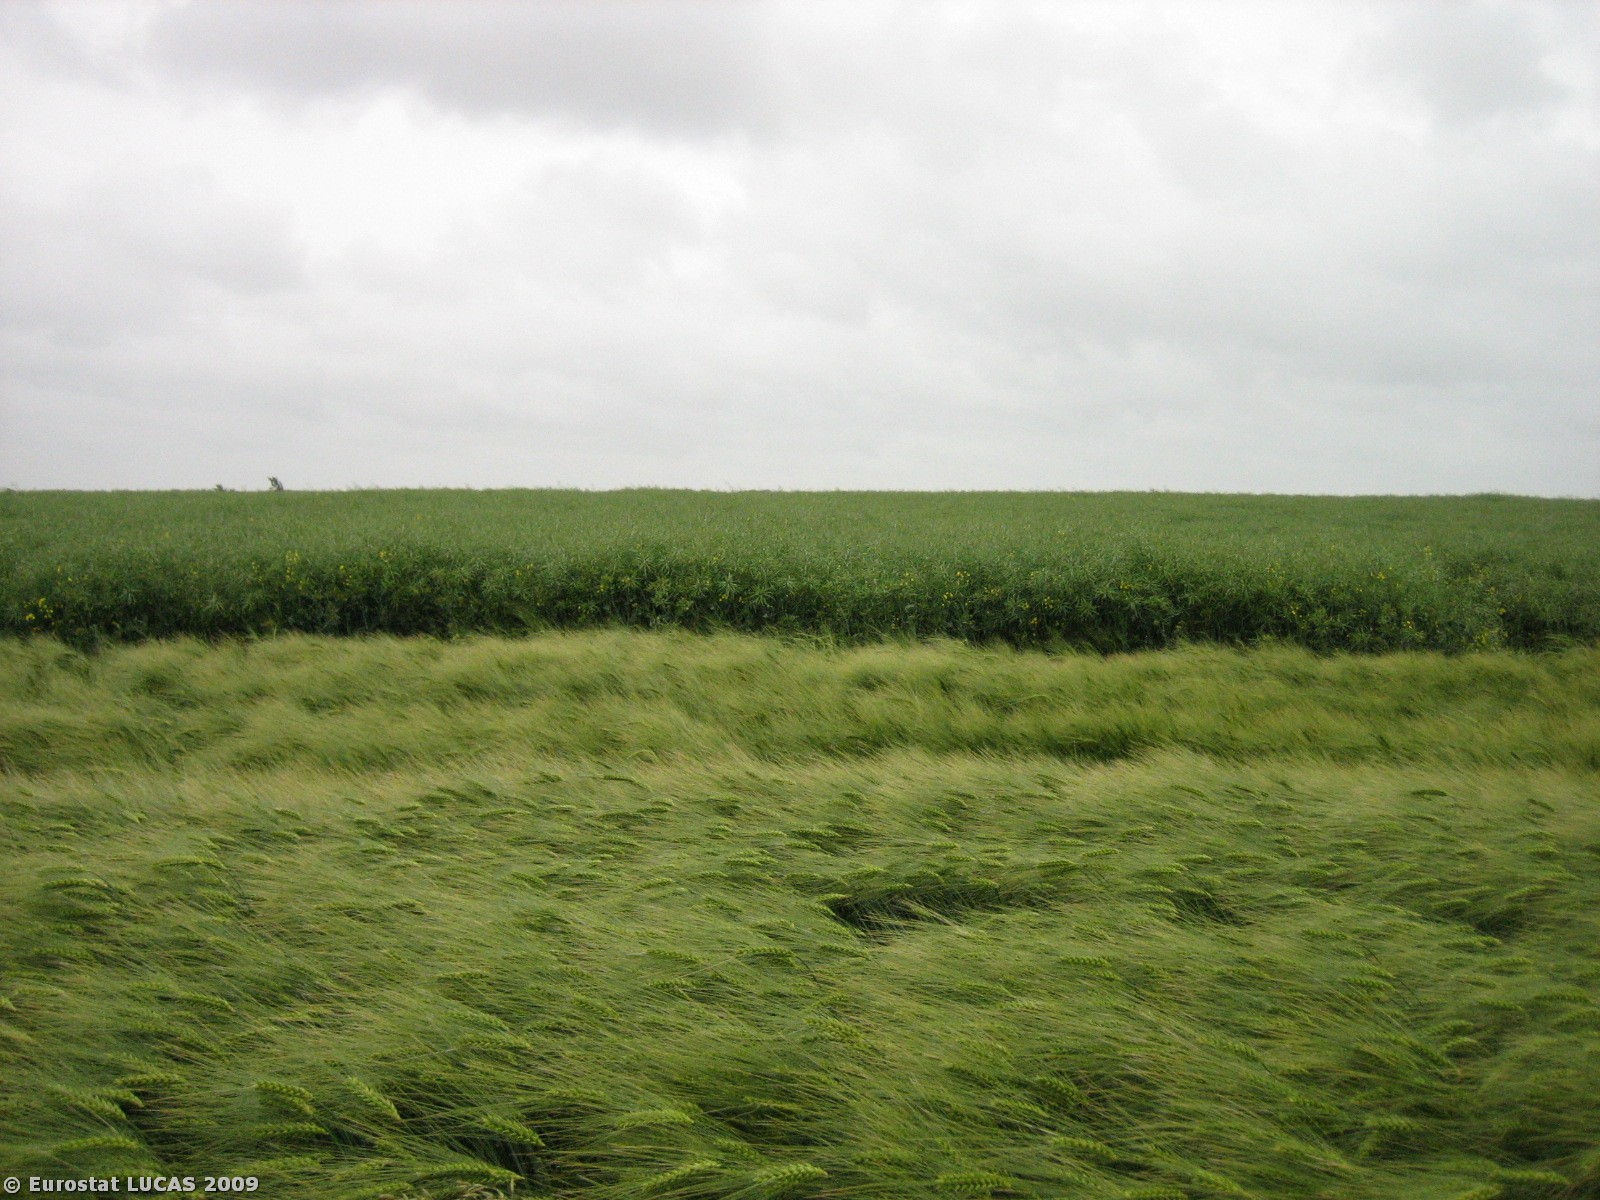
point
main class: Cropland
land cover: Rape and turnip rape
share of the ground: > 75 %
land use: Agriculture (excluding fallow land and kitchen gardens)
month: June
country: DK
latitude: 56.0979
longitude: 10.0161
